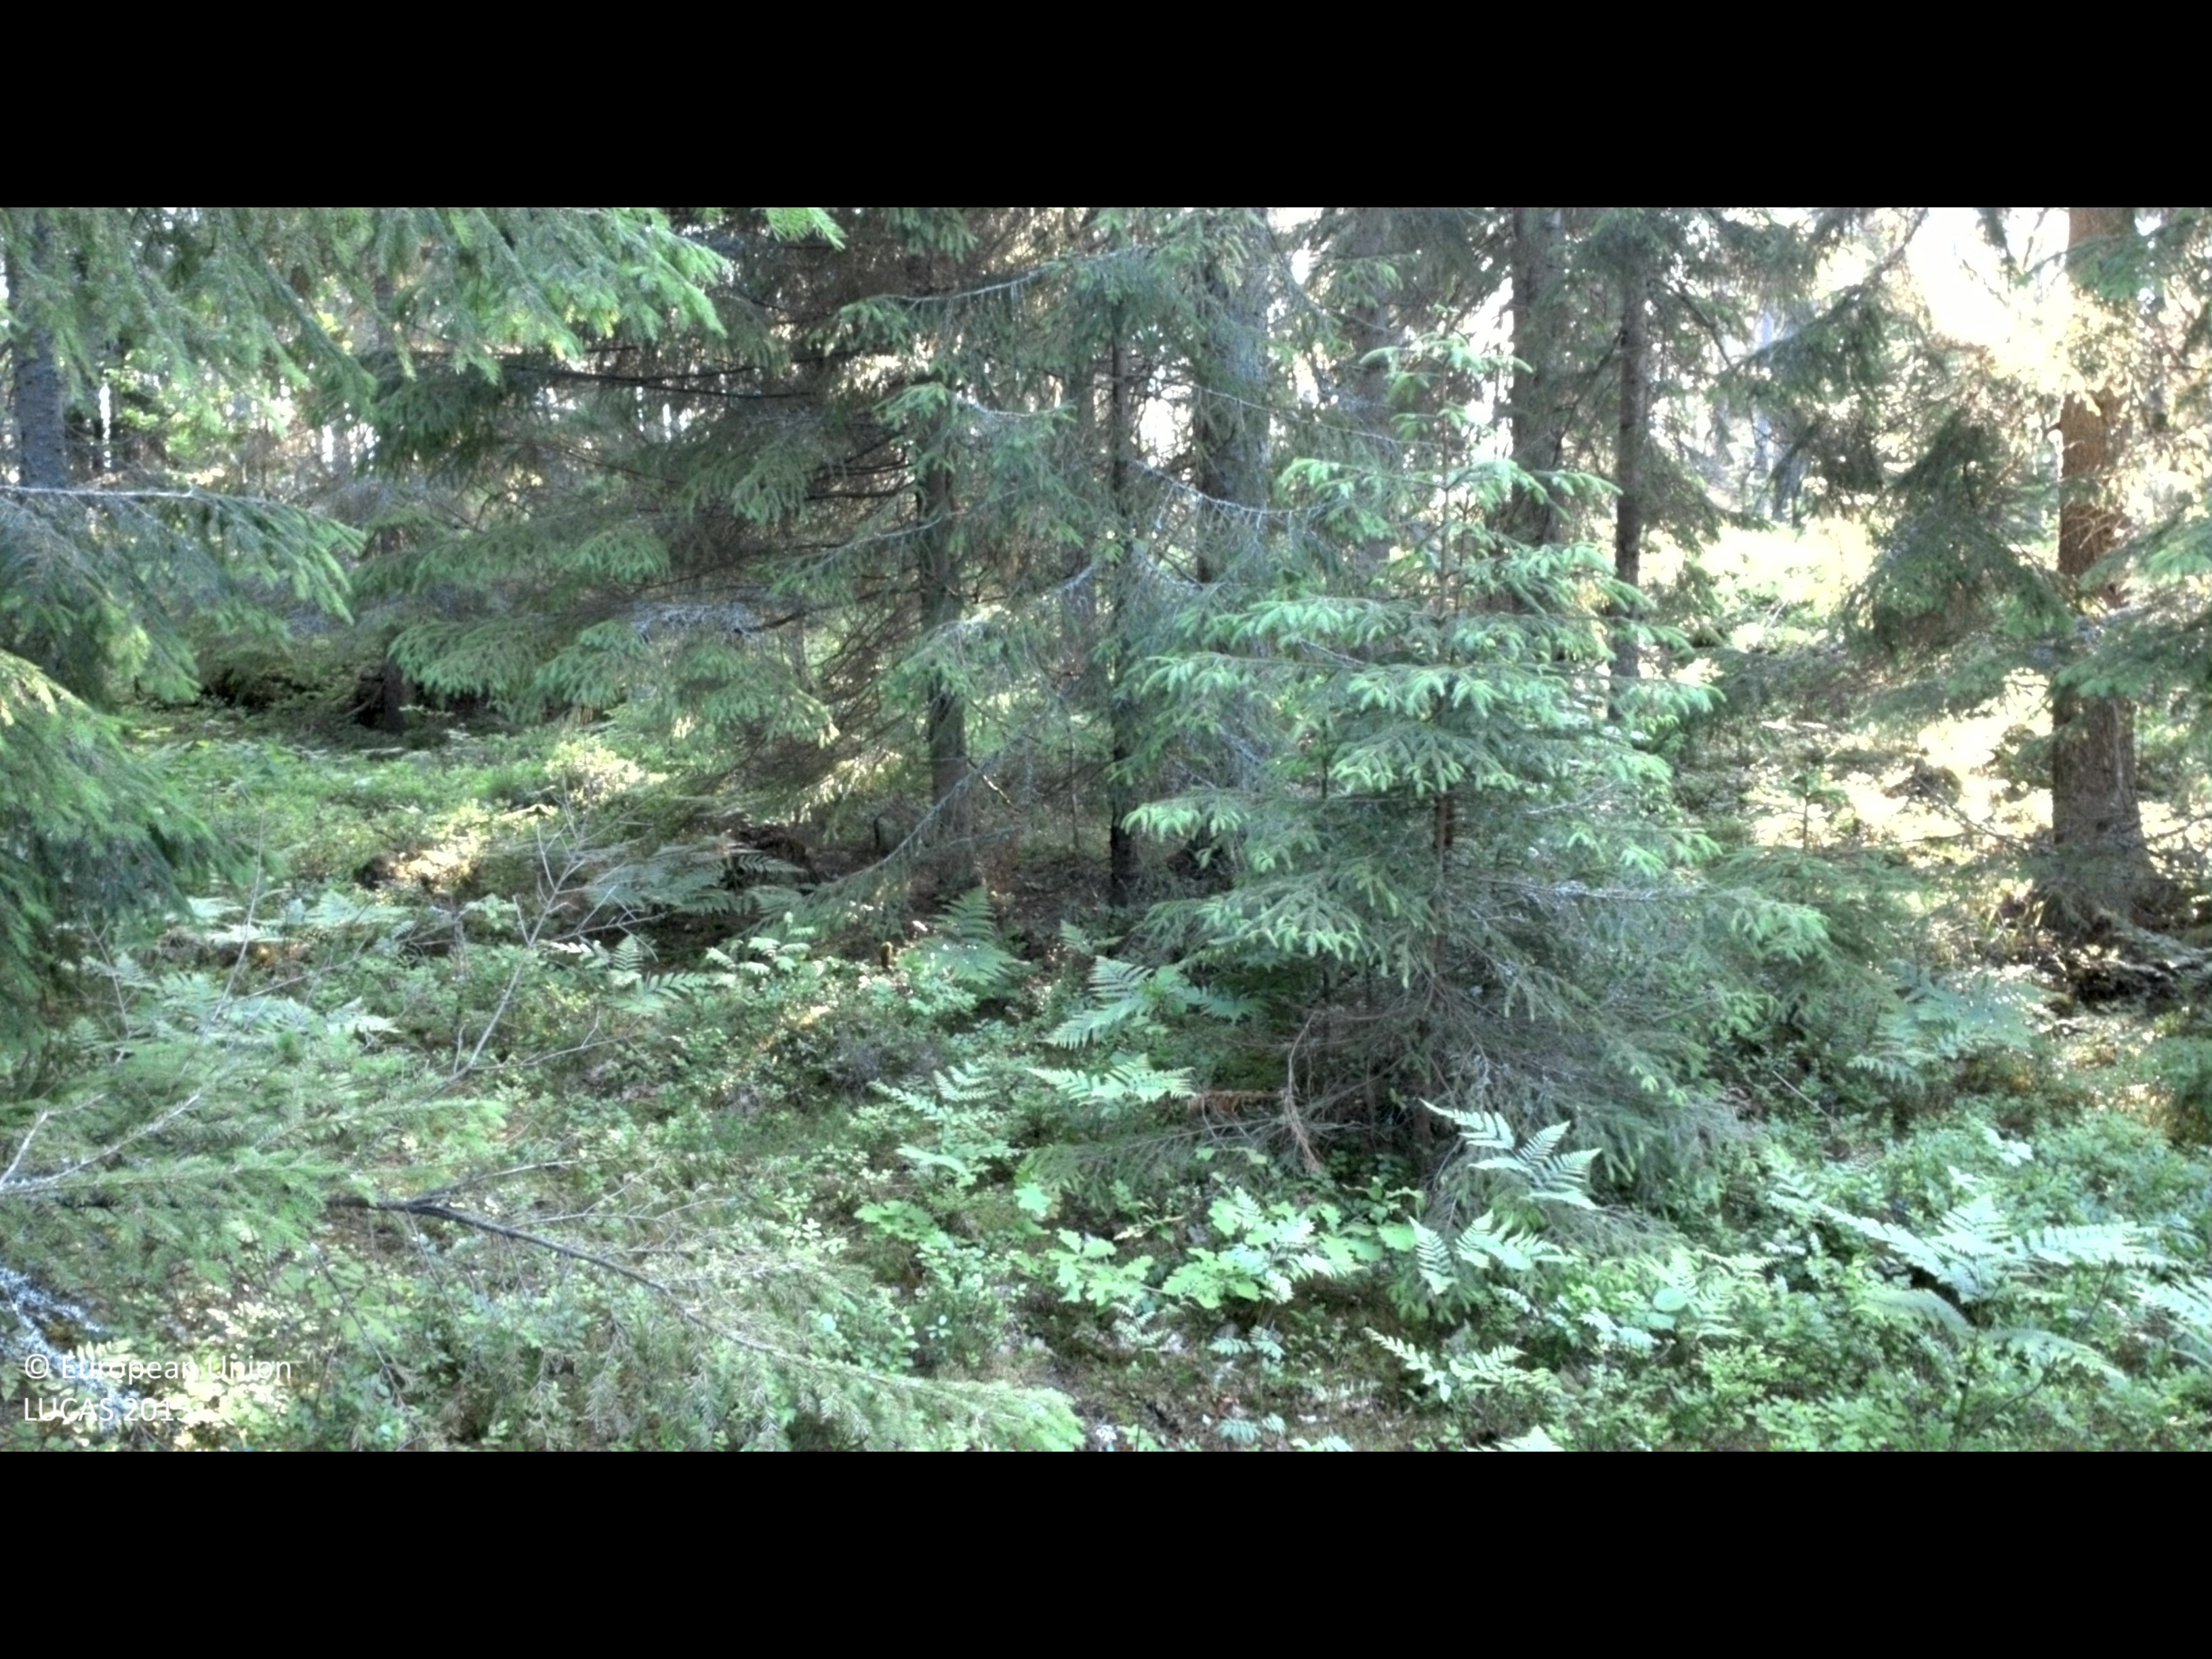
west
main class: Woodland
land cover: Spruce dominated coniferous woodland
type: boreal forest
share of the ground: 50 - 75 %
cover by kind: coniferous forest trees 60 %, shrubs 20 %, herbaceous plants 15 %, broadleaved forest trees 5 %
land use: Forestry
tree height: > 5 m
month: June
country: SE
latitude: 57.9666
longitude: 16.2345
